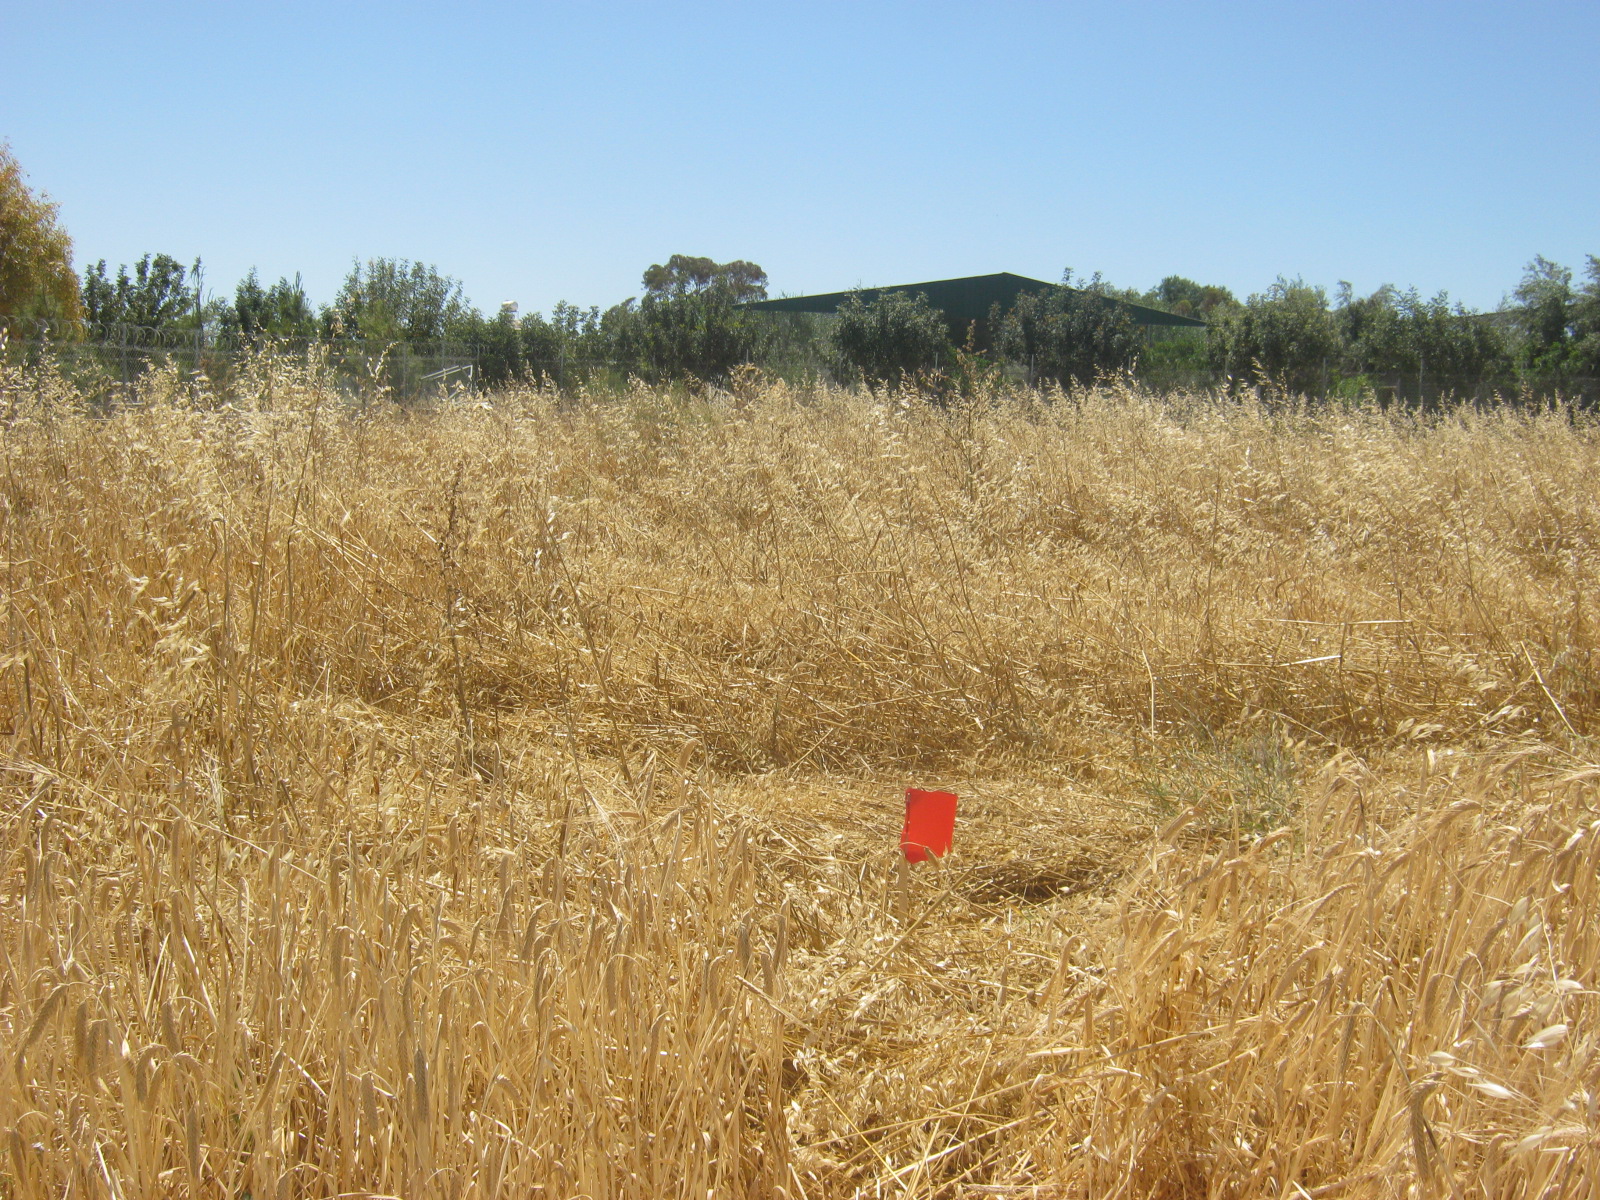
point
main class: Cropland
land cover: Mixed cereals for fodder
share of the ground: > 75 %
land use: Agriculture (excluding fallow land and kitchen gardens)
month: May
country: CY
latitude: 35.1255
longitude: 33.2431
